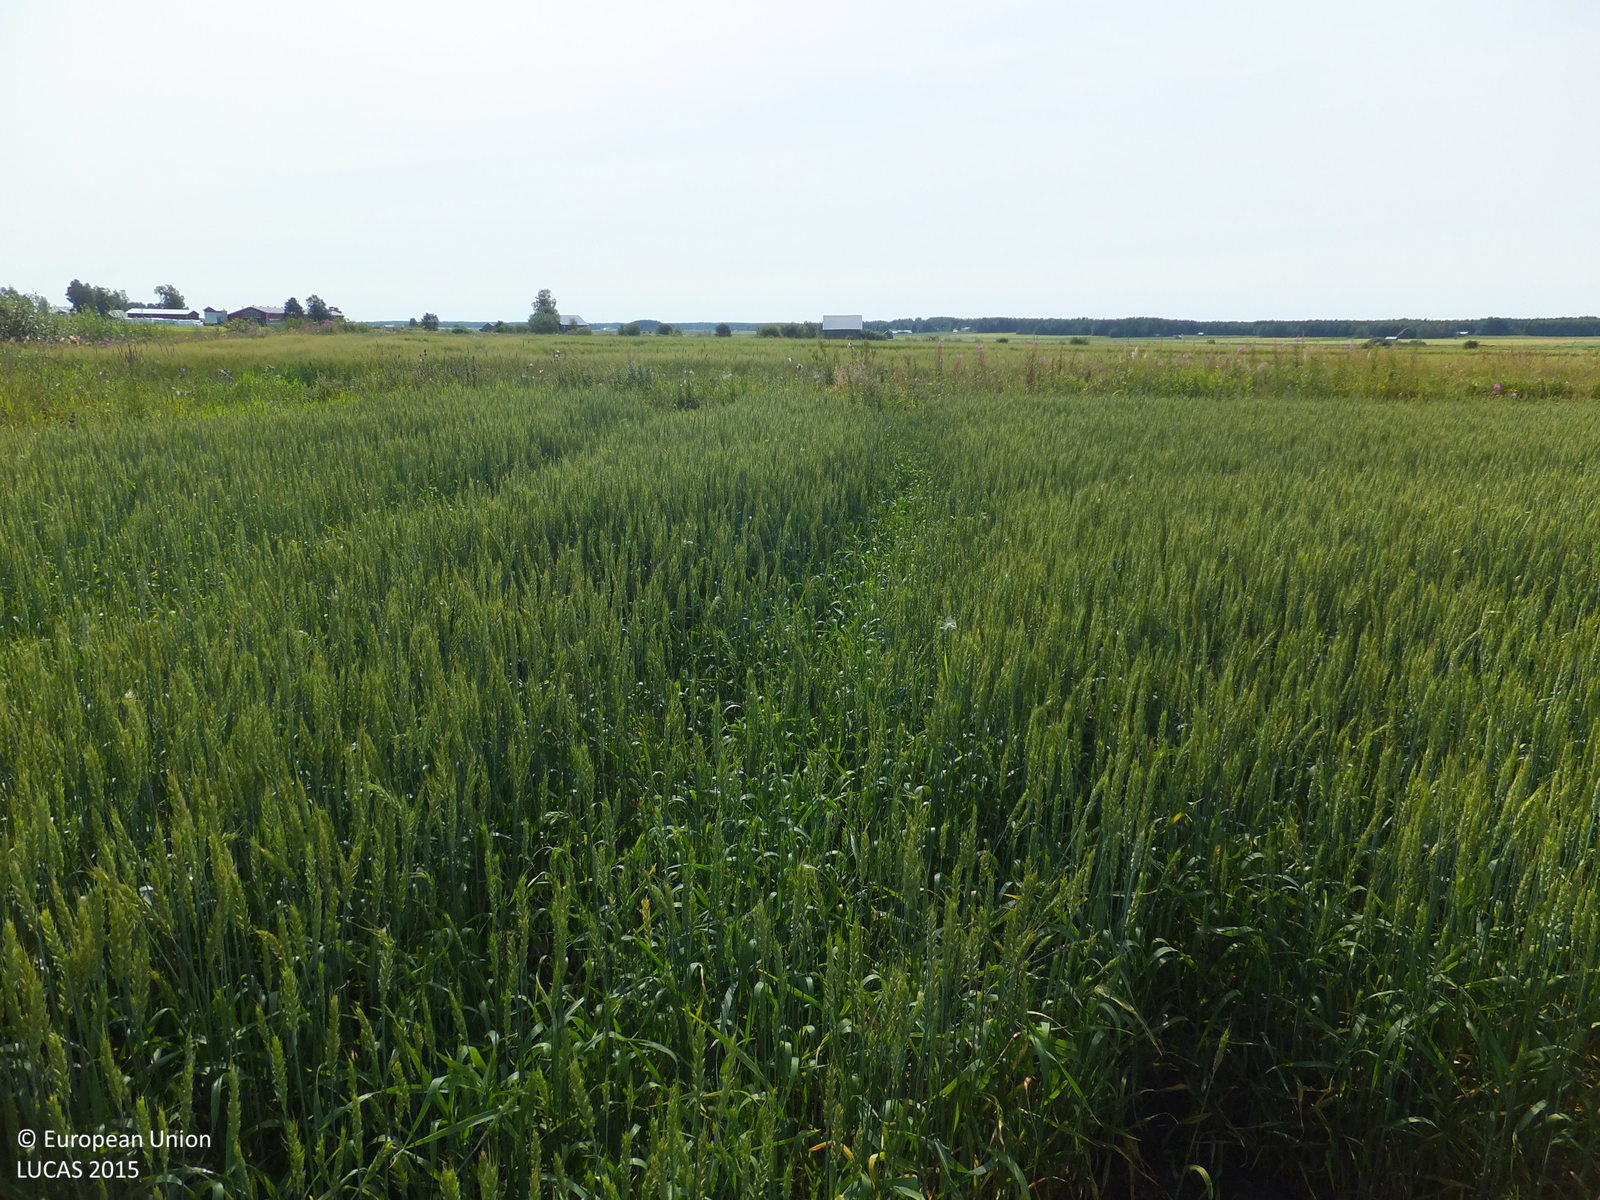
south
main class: Cropland
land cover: Common wheat
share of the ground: > 75 %
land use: Agriculture (excluding fallow land and kitchen gardens)
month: August
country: FI
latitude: 63.2170
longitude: 22.8043
